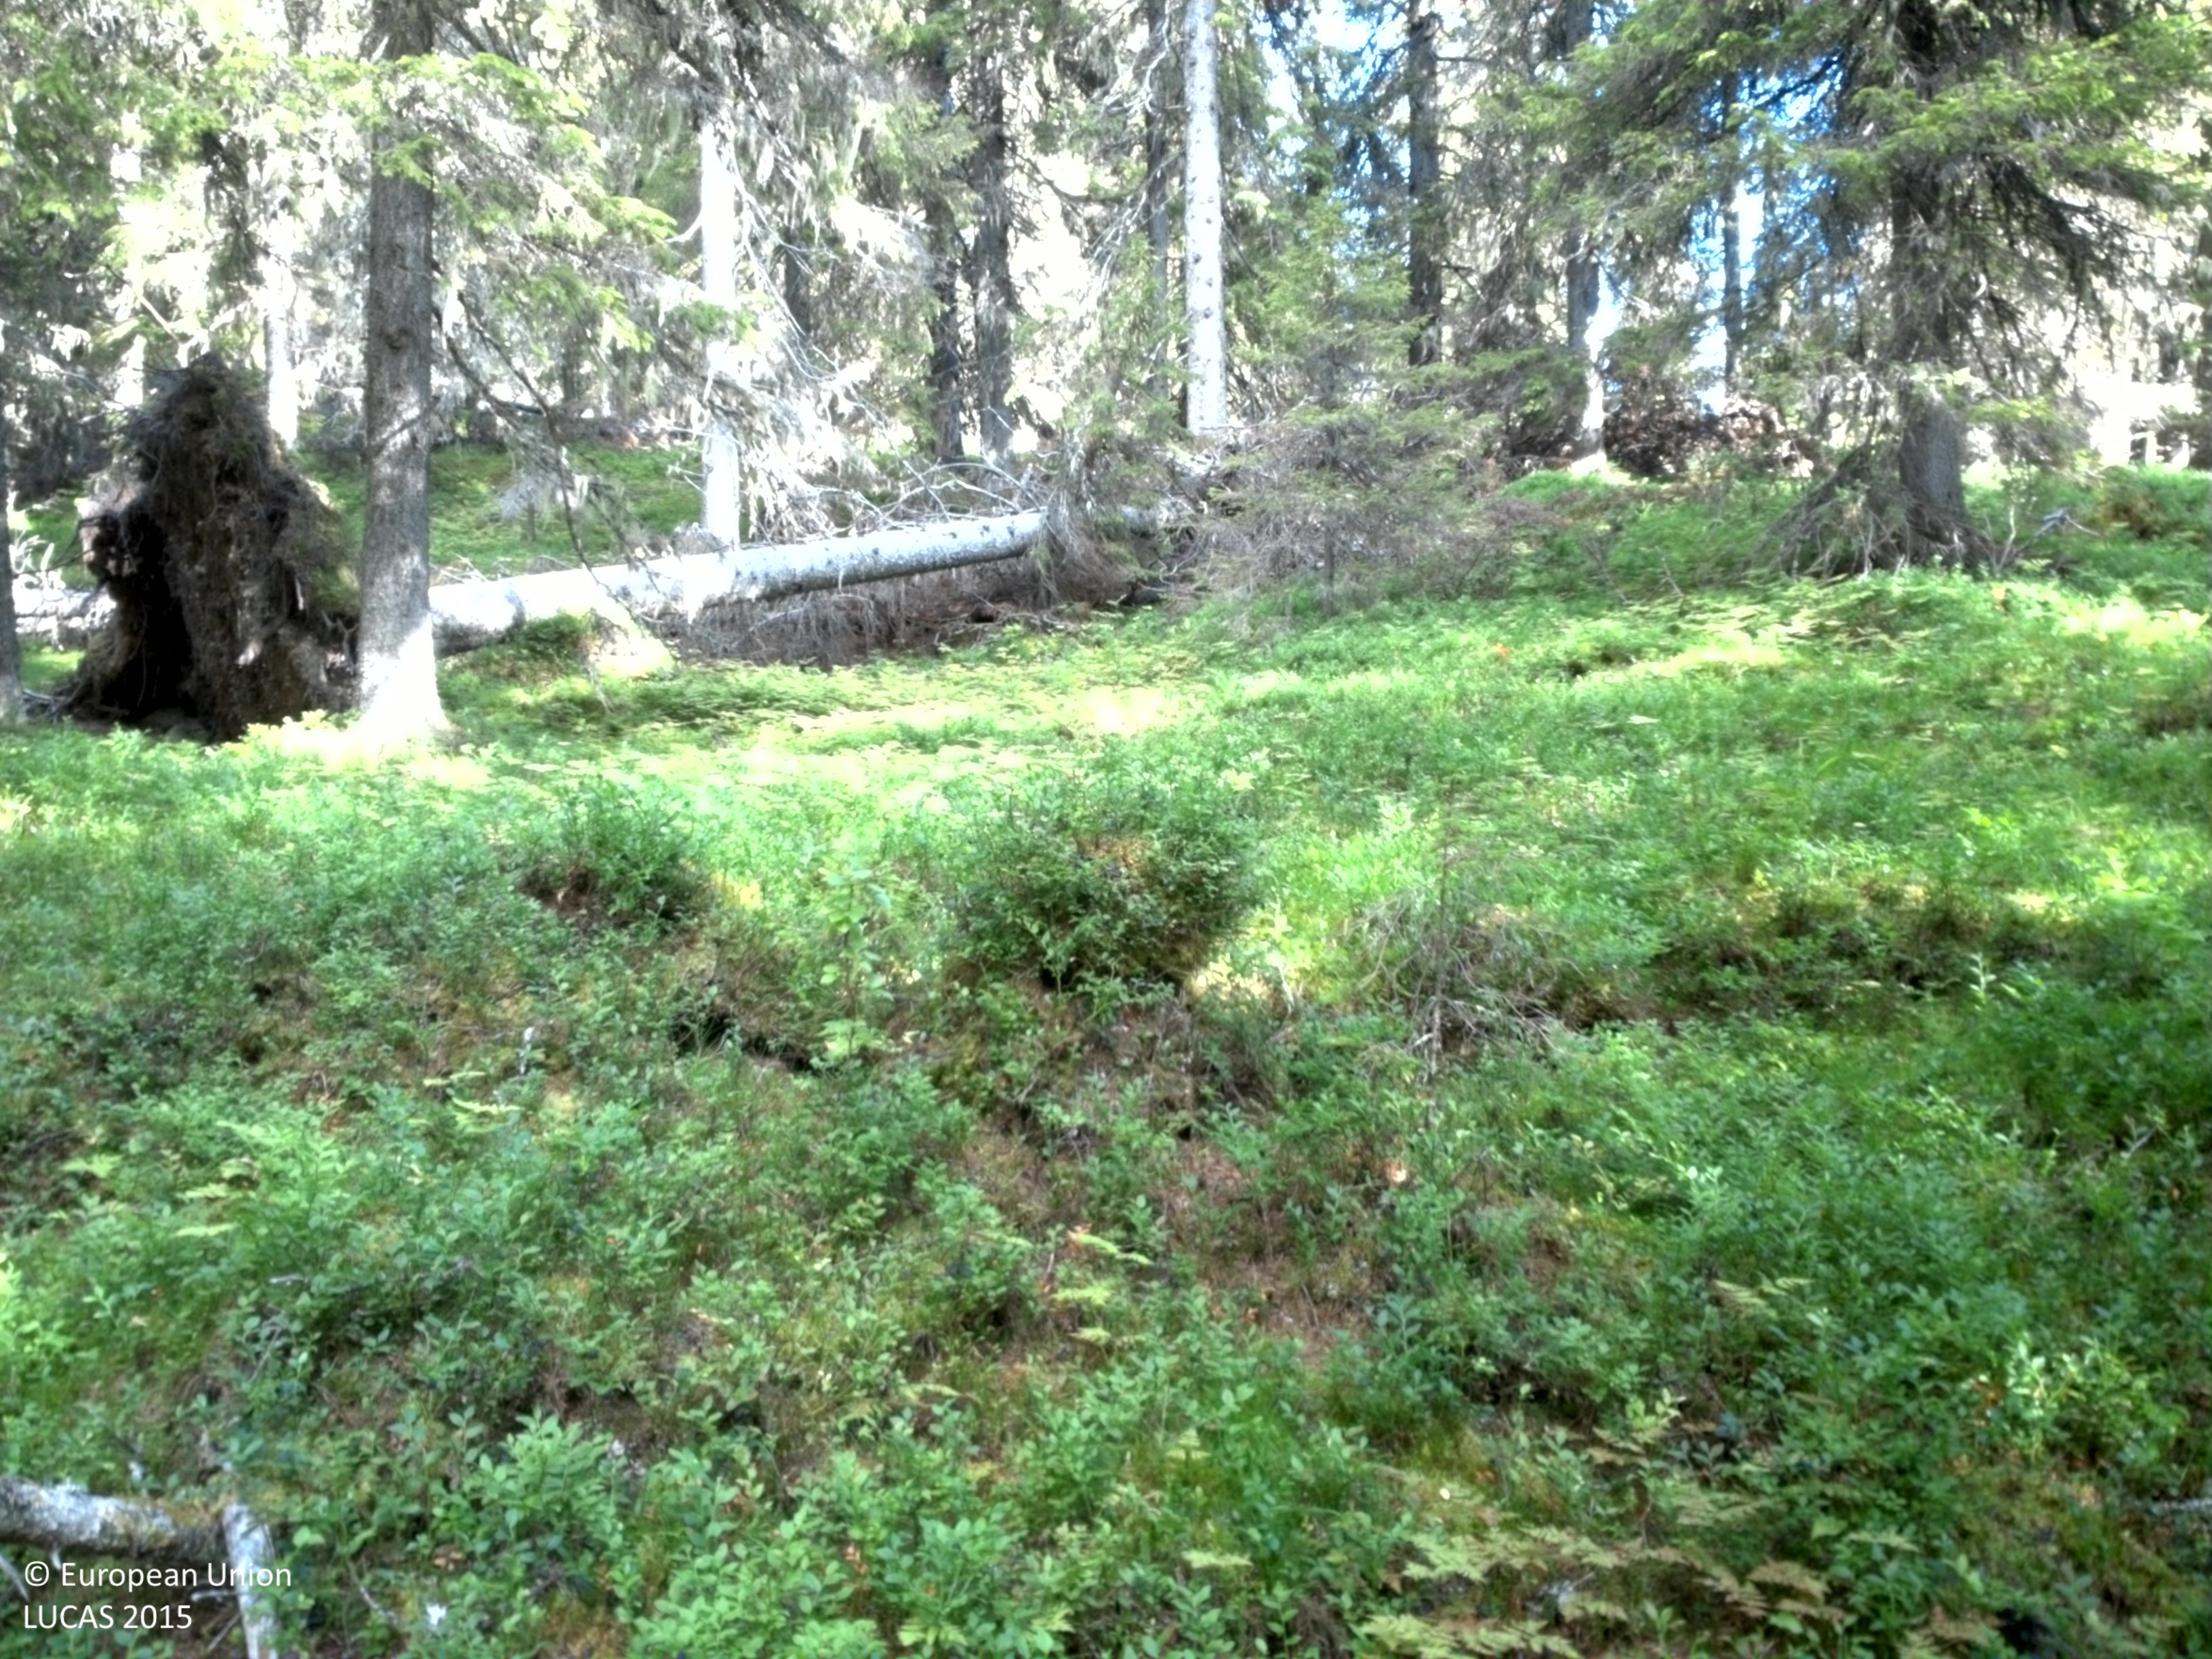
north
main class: Woodland
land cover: Spruce dominated coniferous woodland
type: boreal forest
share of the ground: 50 - 75 %
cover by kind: coniferous forest trees 60 %, shrubs 20 %, lichens and mosses 15 %, herbaceous plants 5 %
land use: Forestry
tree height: > 5 m
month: September
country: SE
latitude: 65.0255
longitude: 16.5236
